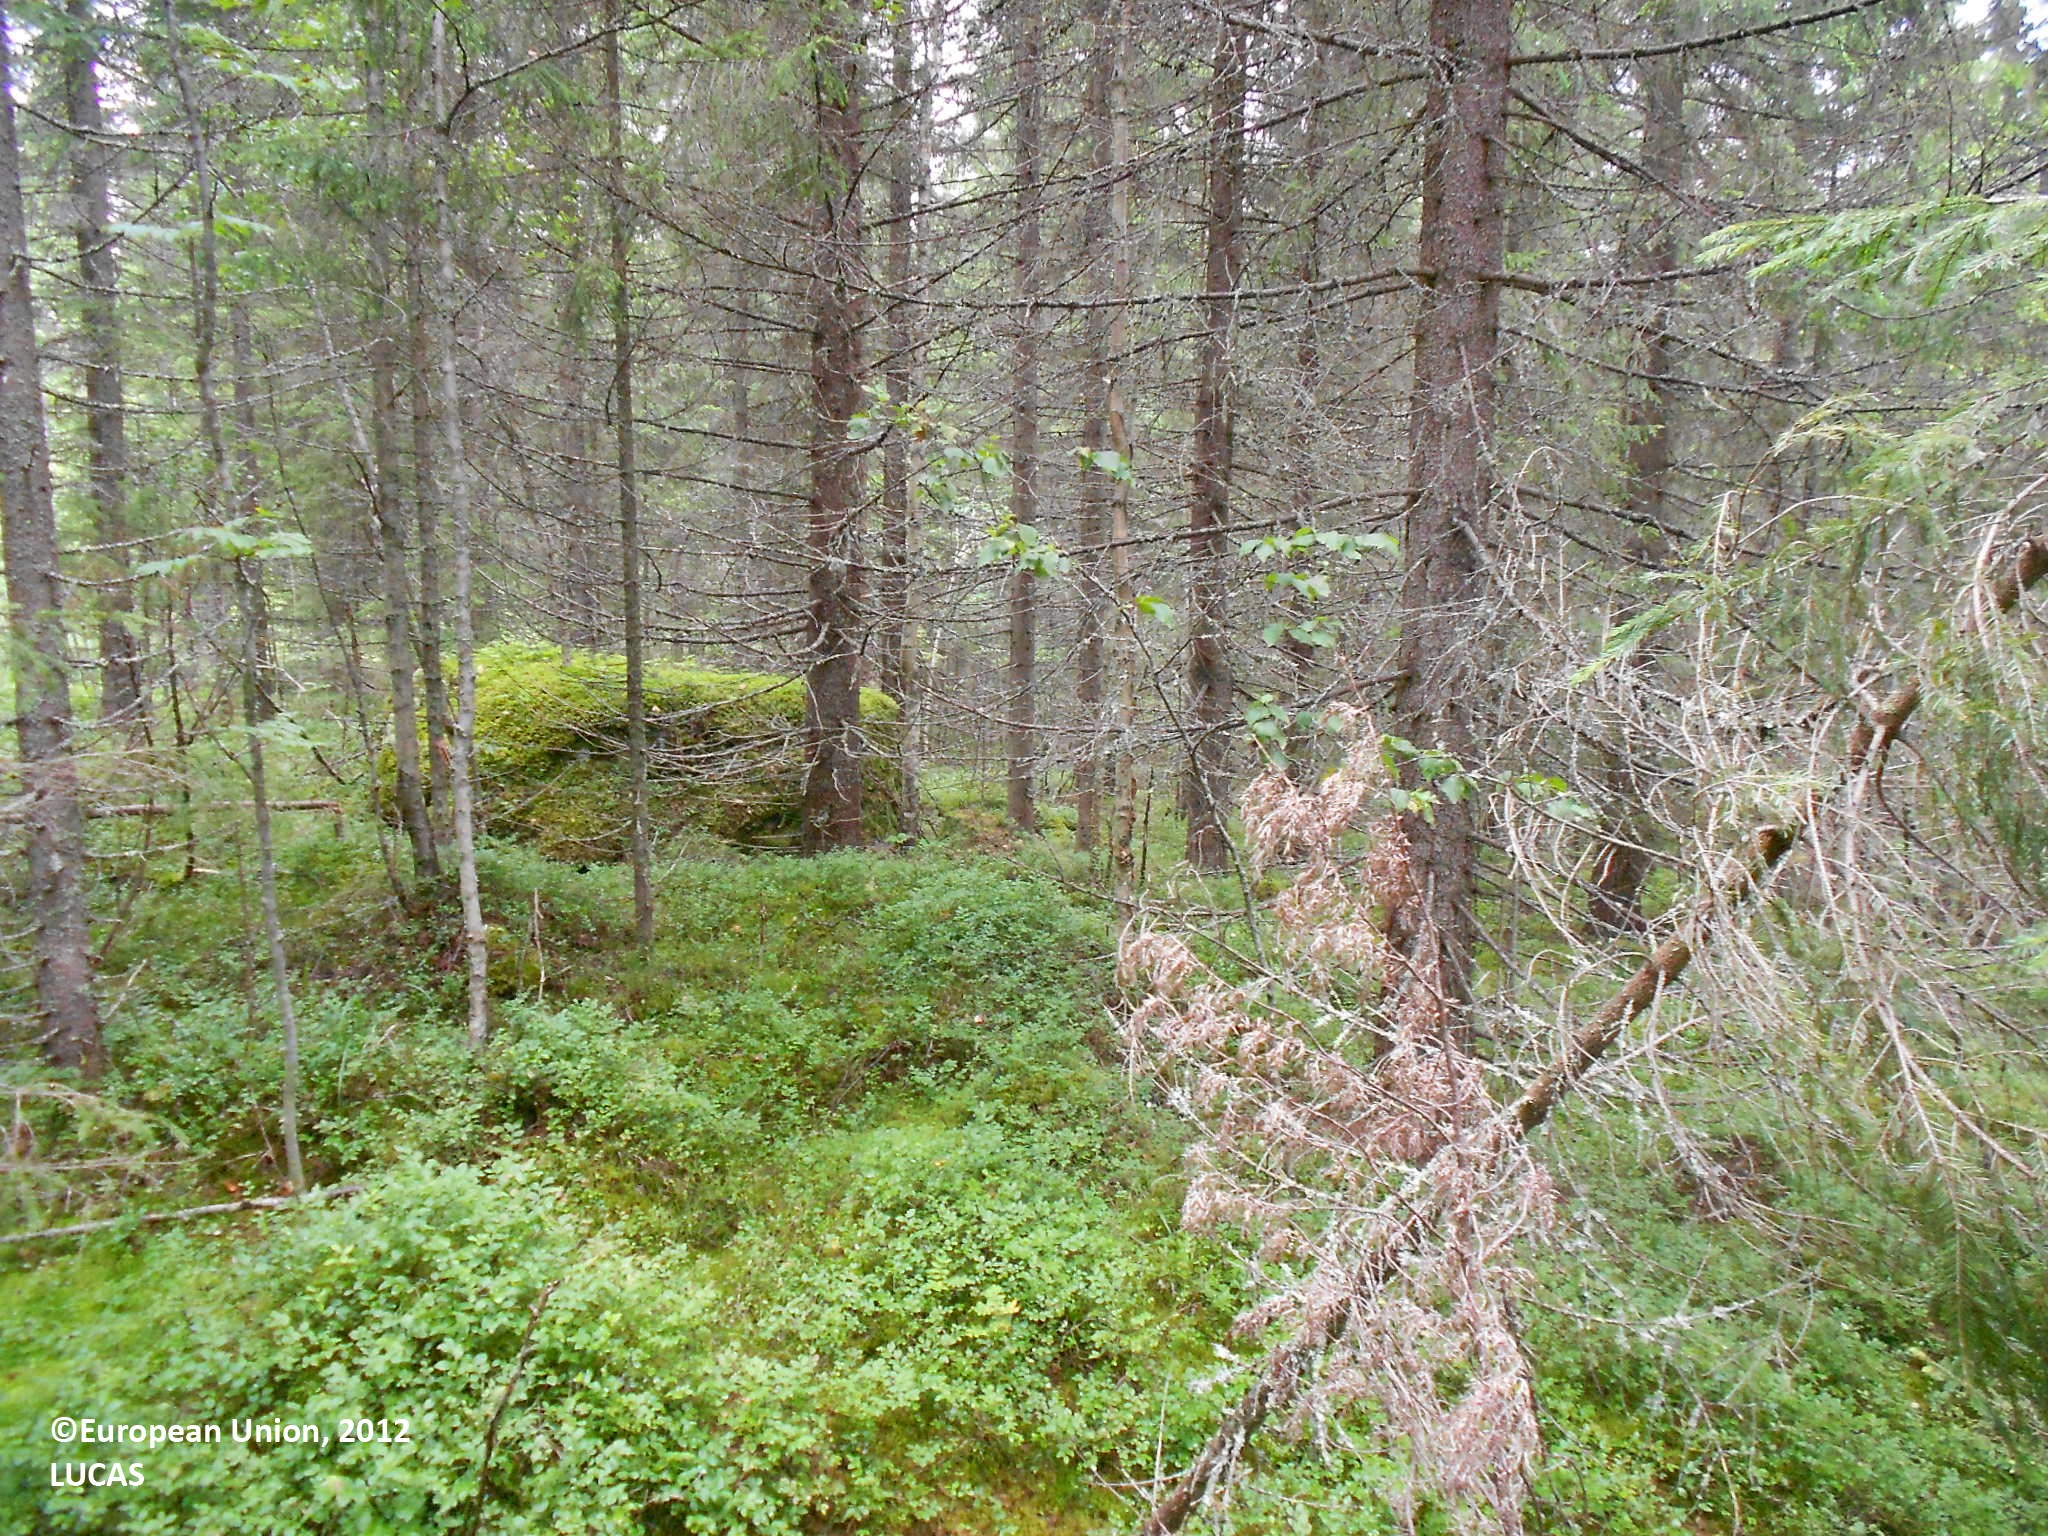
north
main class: Woodland
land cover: Spruce dominated coniferous woodland
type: boreal forest
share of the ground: > 75 %
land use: Forestry
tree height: > 5 m
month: August
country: FI
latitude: 63.4656
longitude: 28.9247
